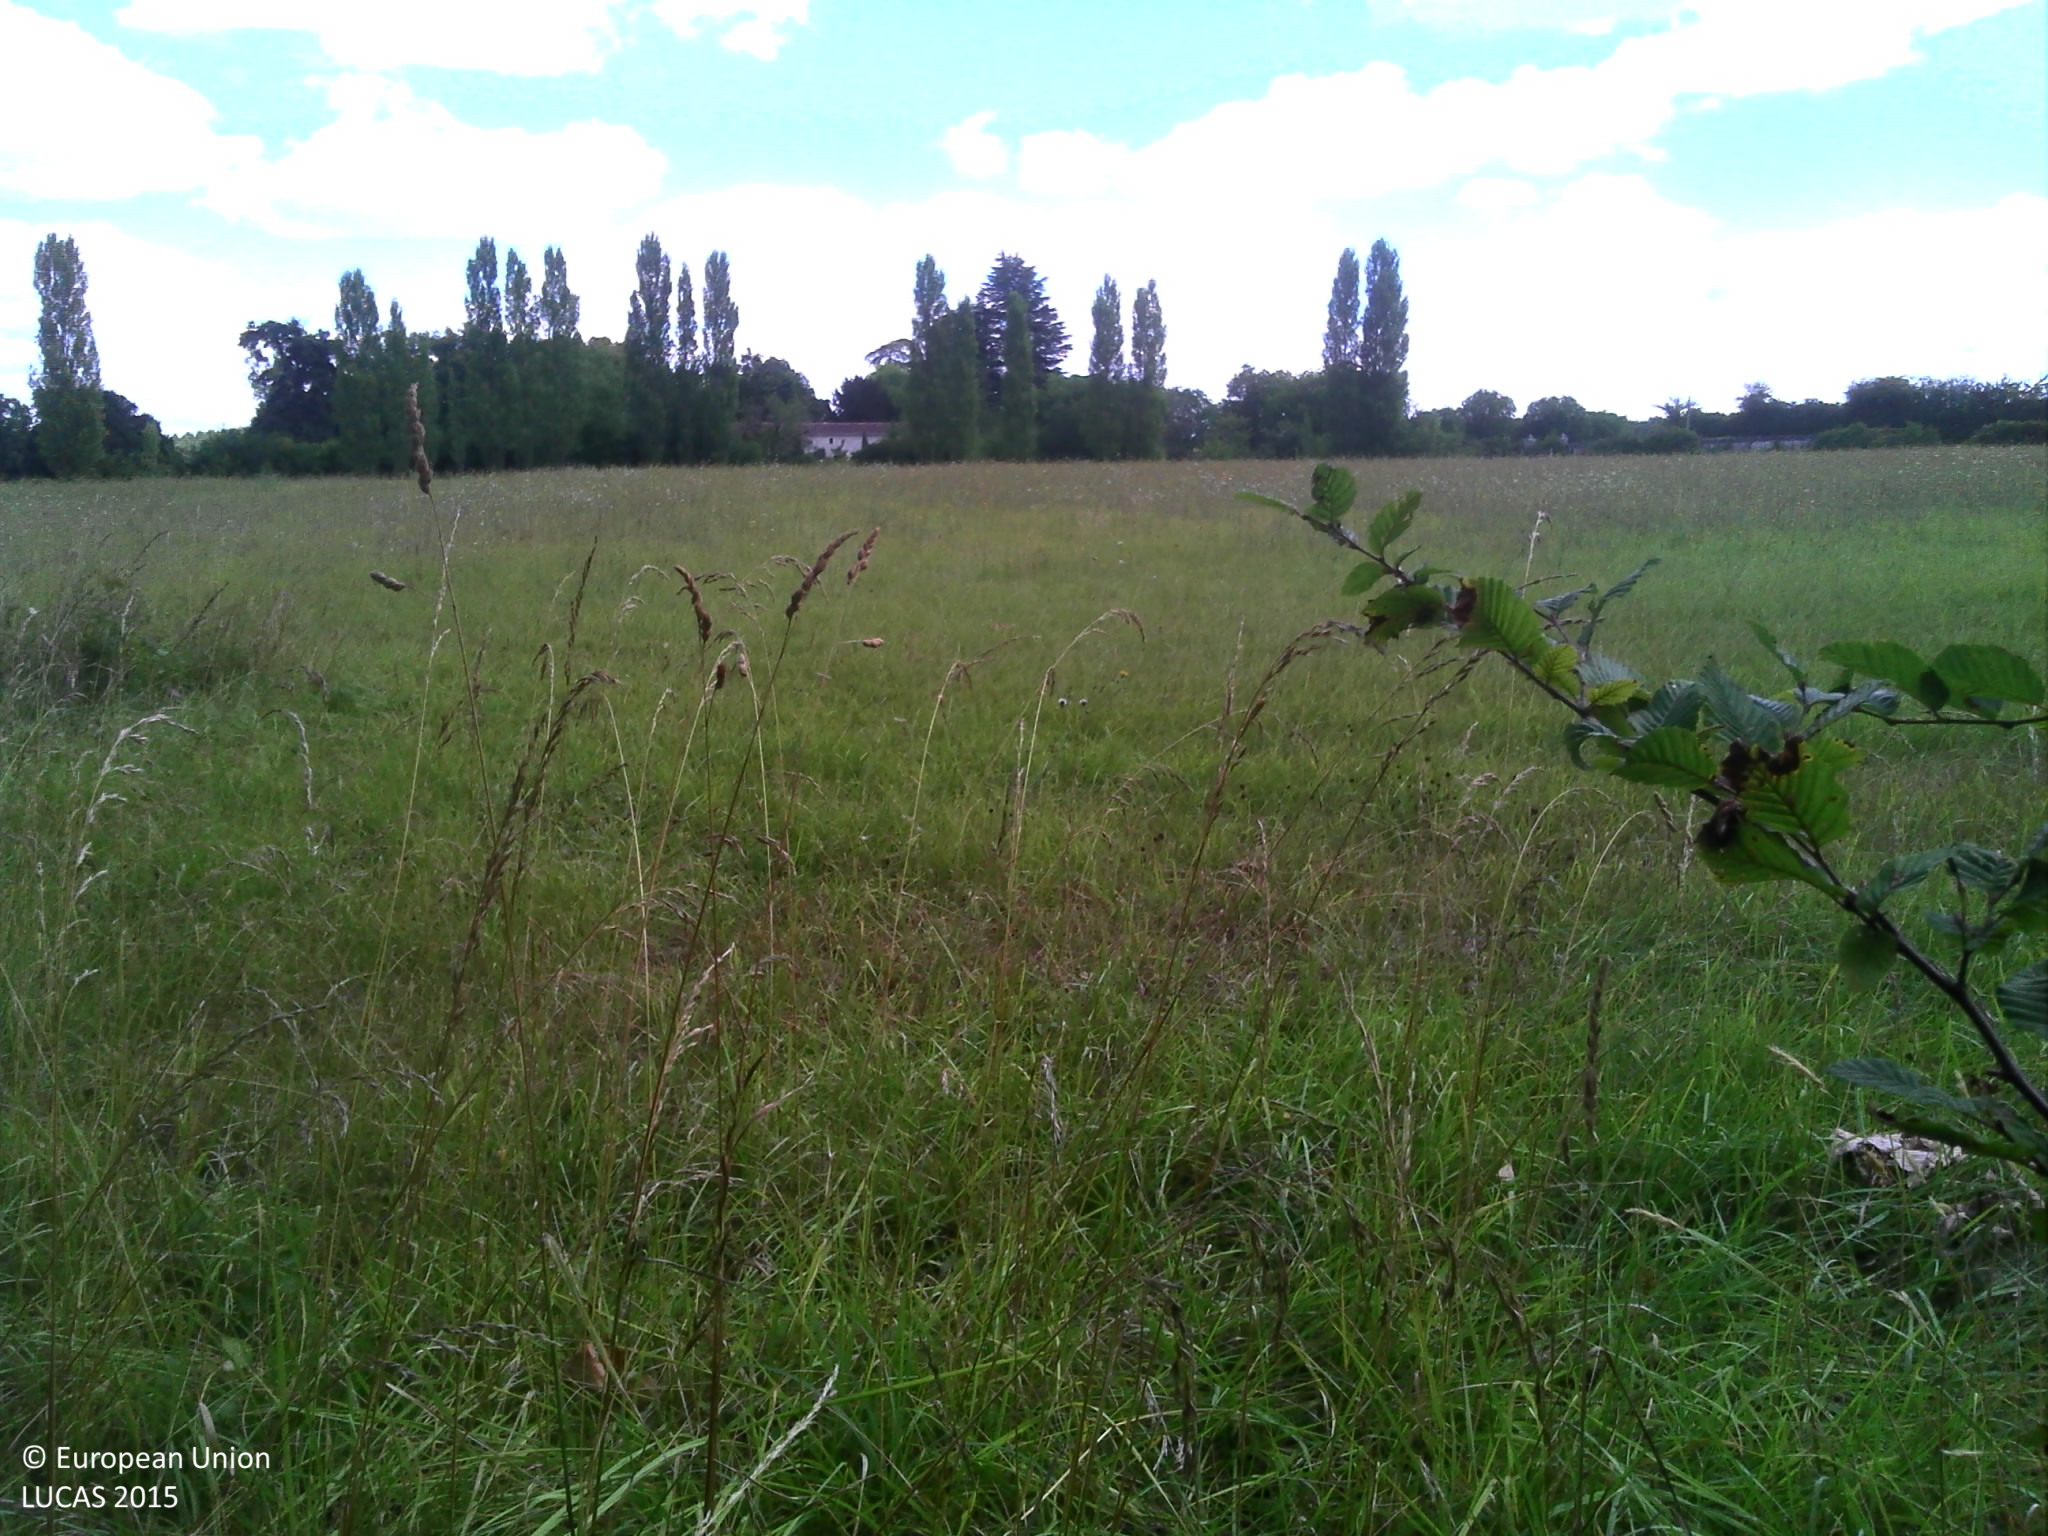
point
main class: Grassland
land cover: Grassland without tree/shrub cover
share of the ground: > 75 %
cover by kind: herbaceous plants 100 %
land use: Amenities, museums, leisure
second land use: Residential
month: July
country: FR
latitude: 47.0210
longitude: 0.3620
